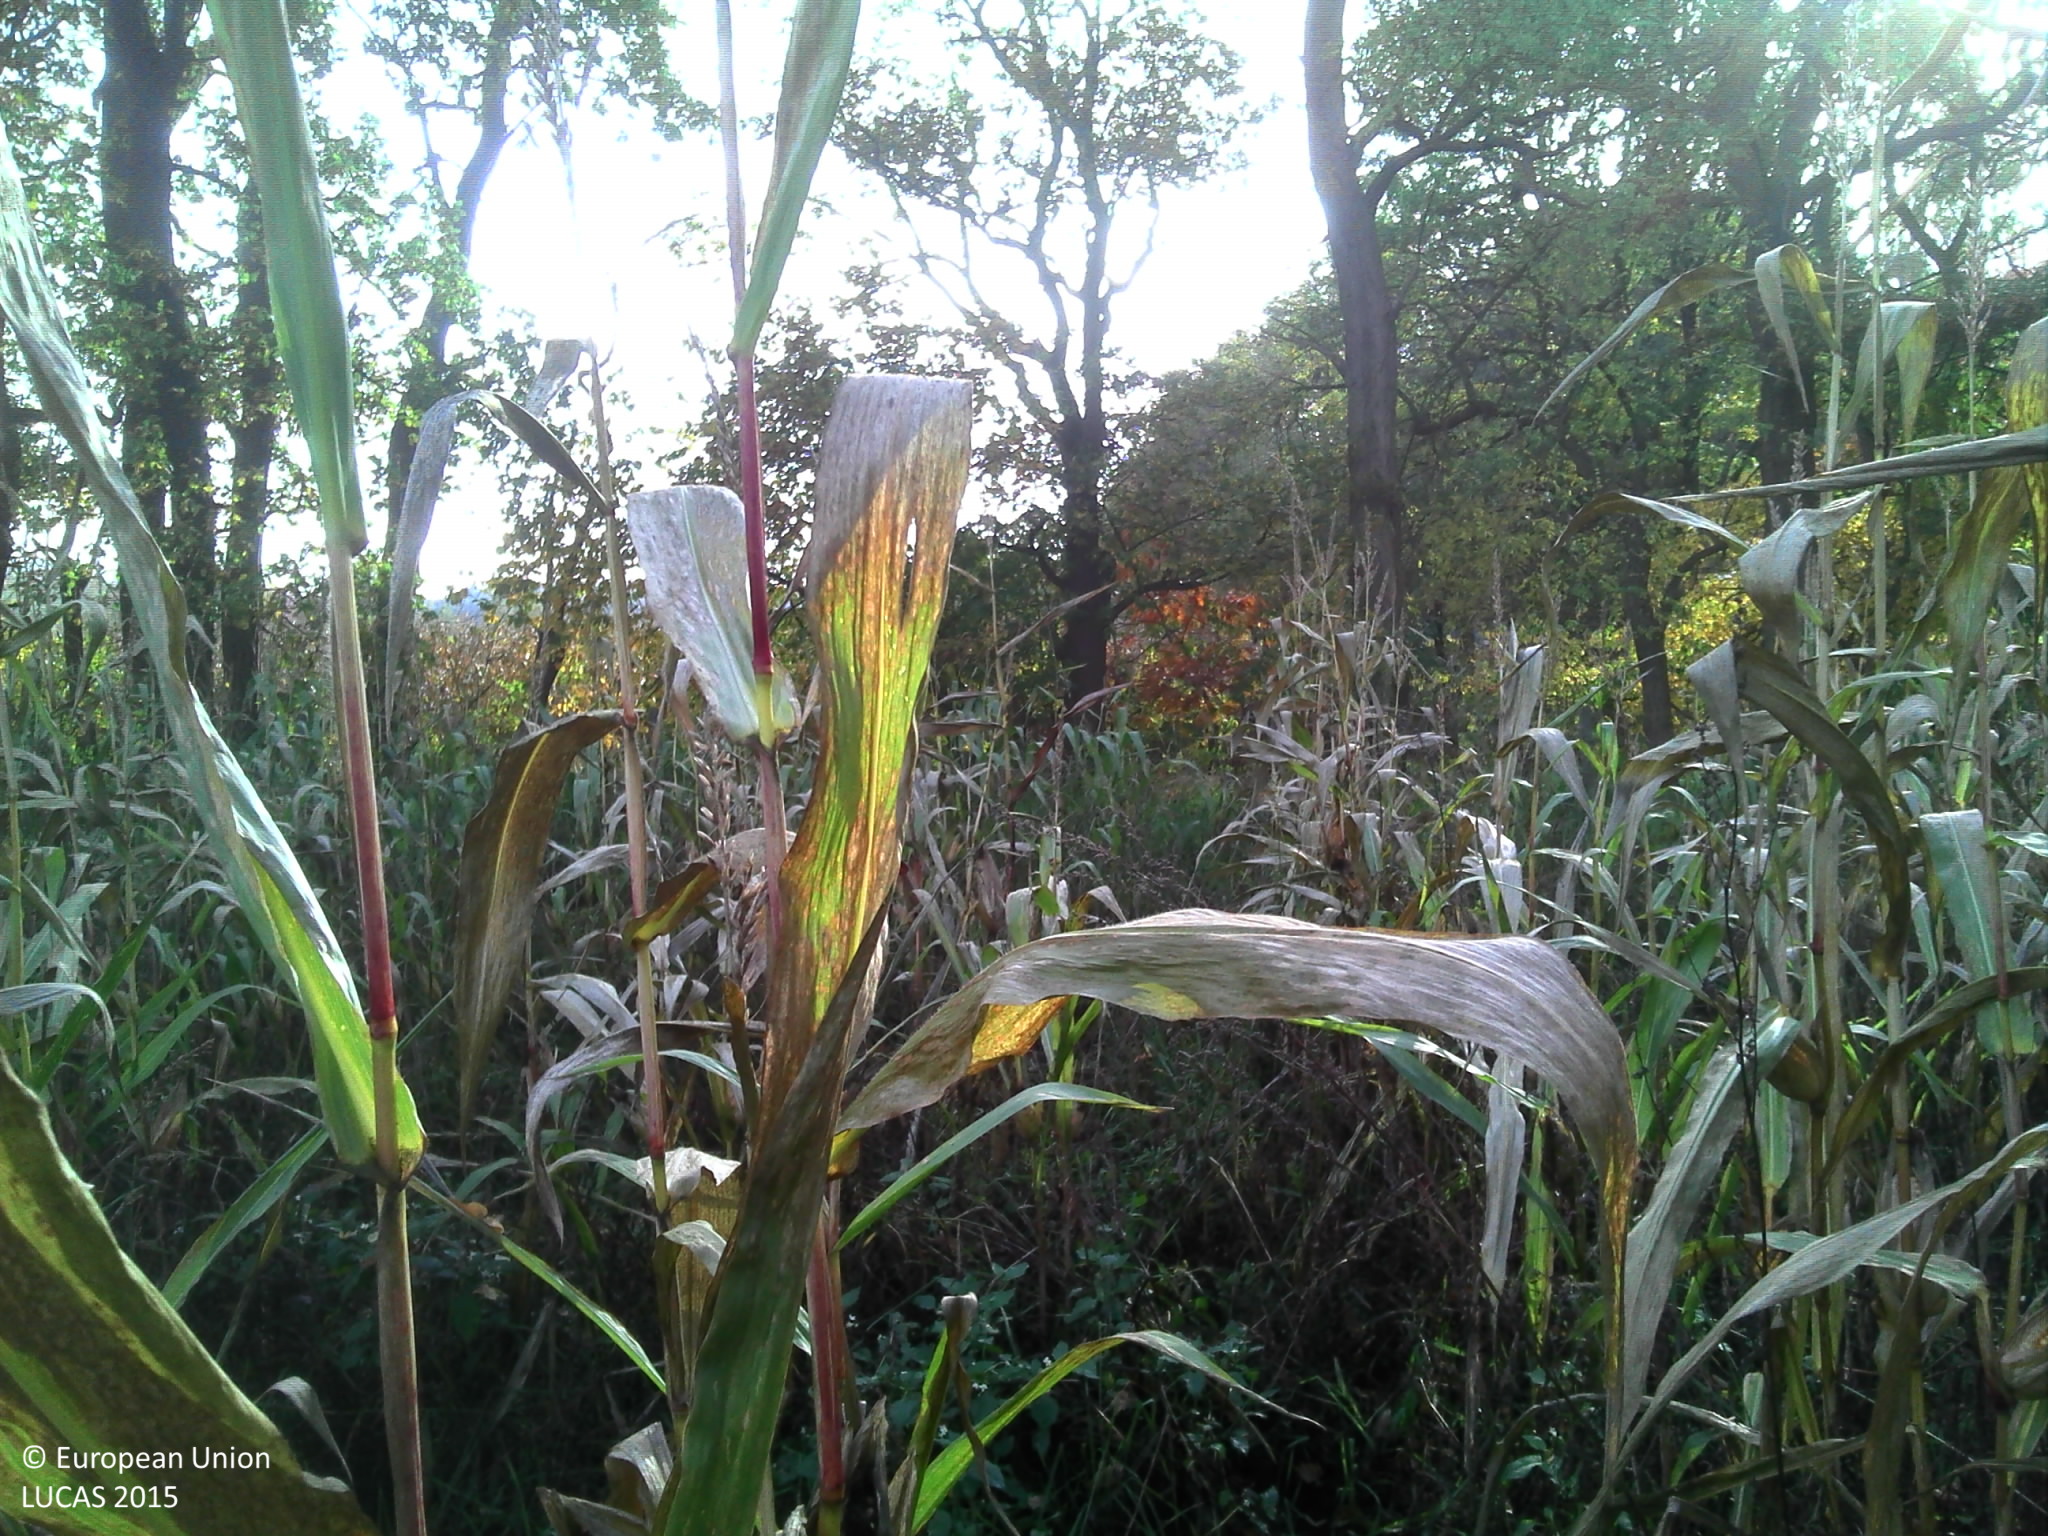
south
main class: Cropland
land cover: Maize
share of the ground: > 75 %
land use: Agriculture (excluding fallow land and kitchen gardens)
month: October
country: BE
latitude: 51.0351
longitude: 5.1346
